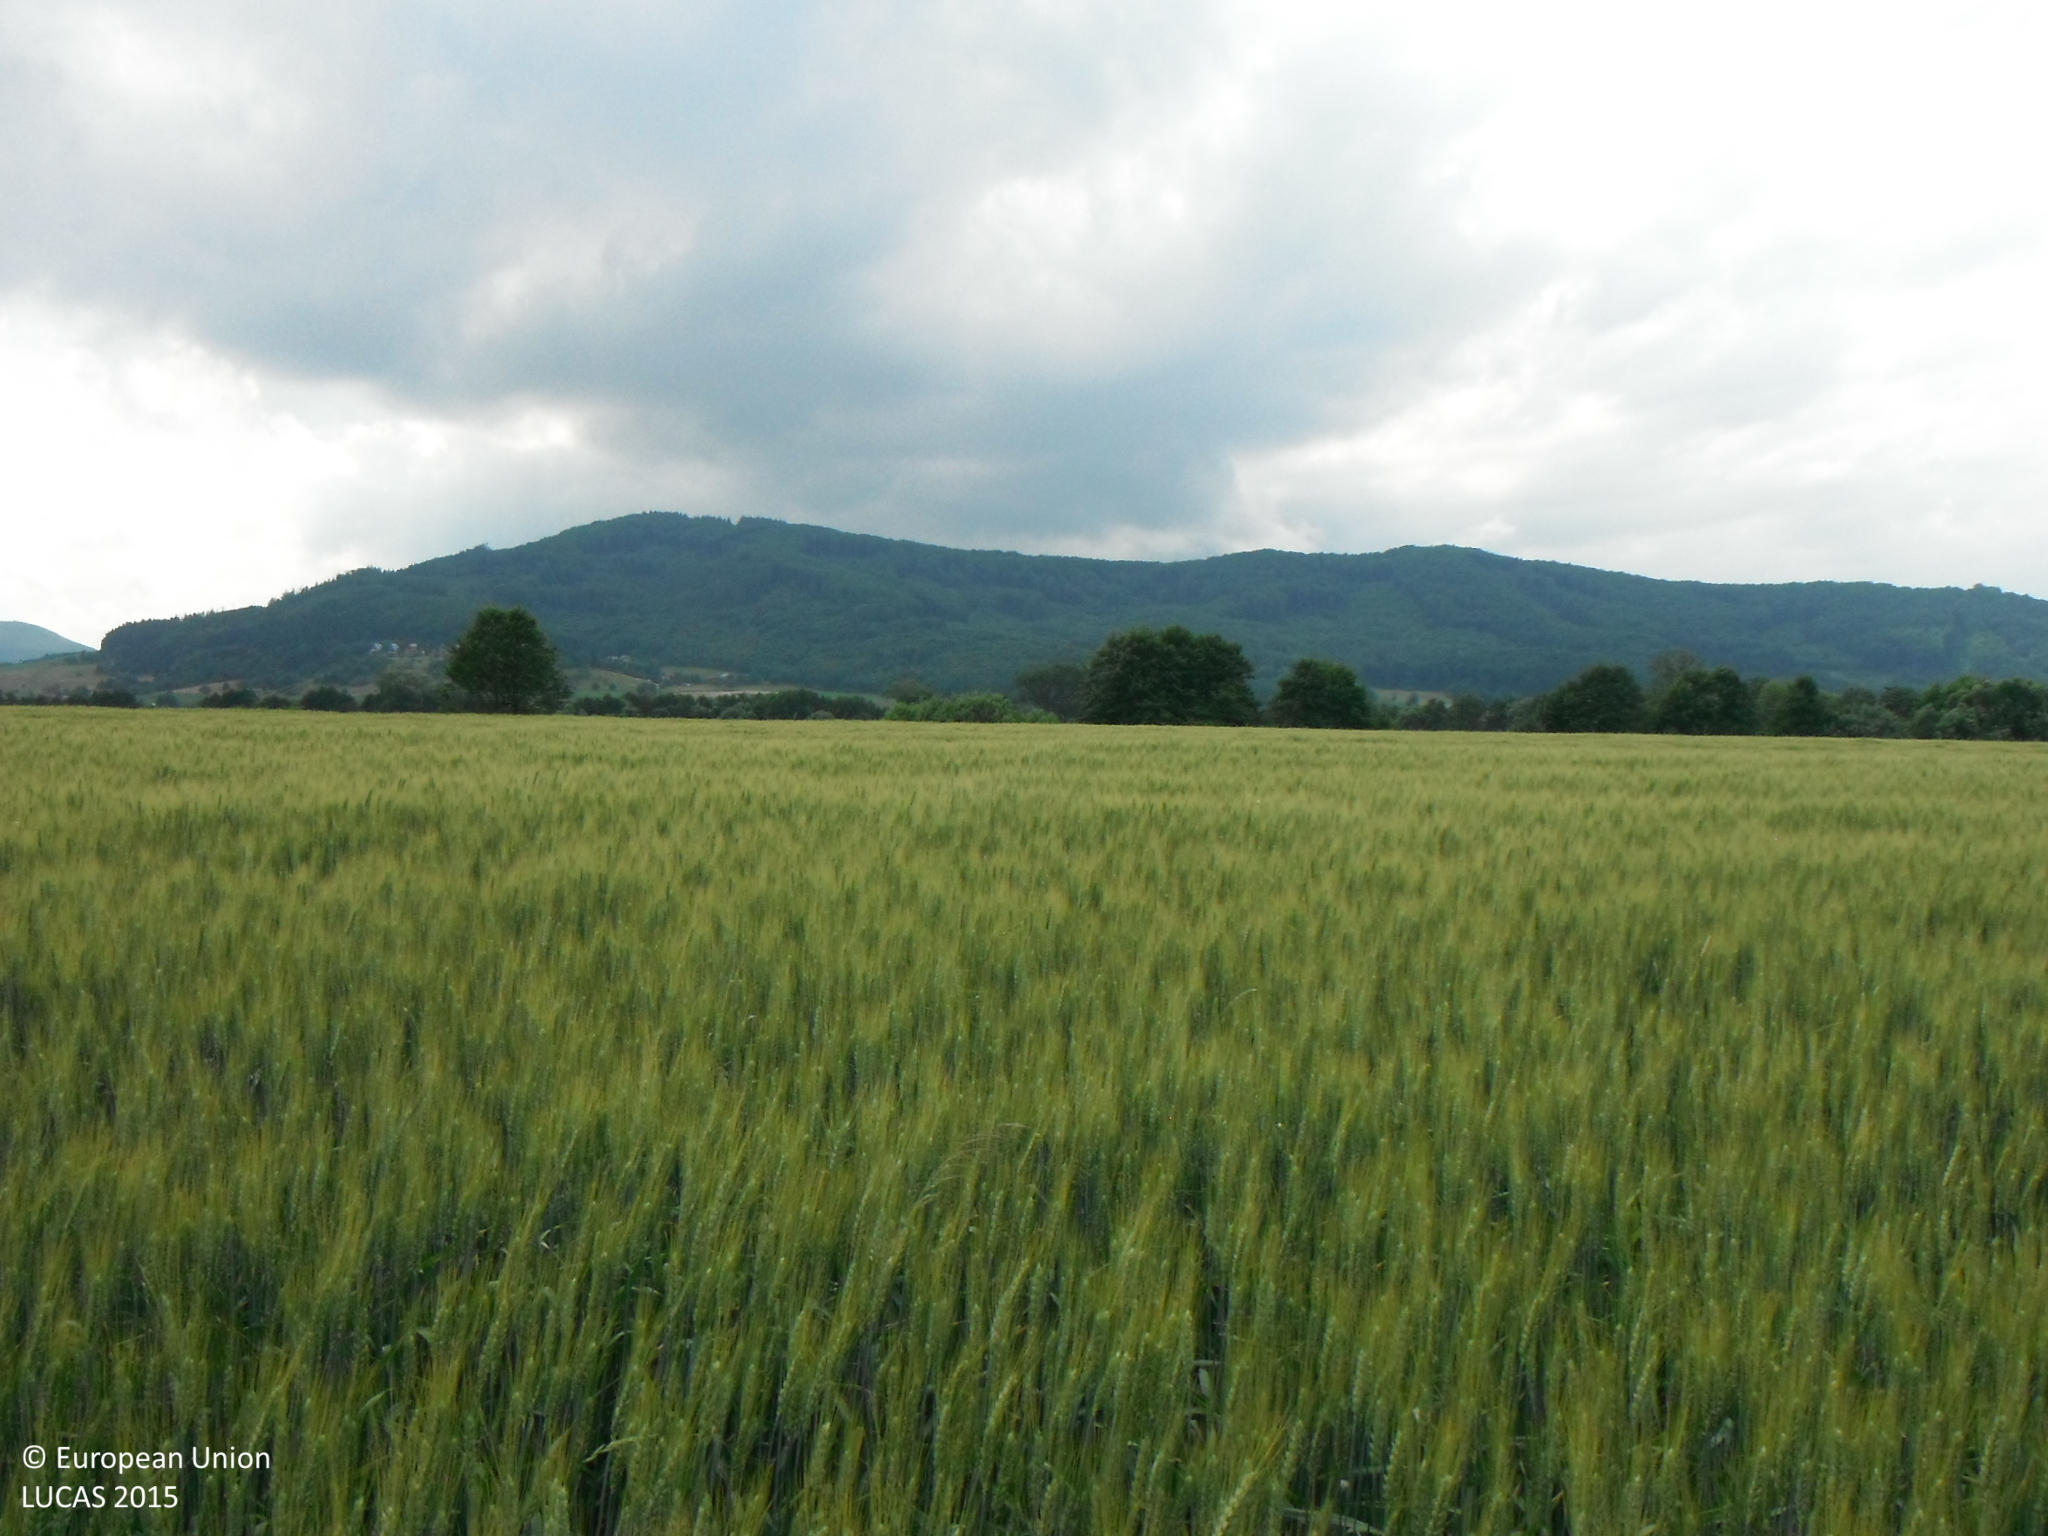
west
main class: Cropland
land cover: Common wheat
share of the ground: > 75 %
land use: Agriculture (excluding fallow land and kitchen gardens)
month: June
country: SK
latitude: 48.5159
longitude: 19.3239
